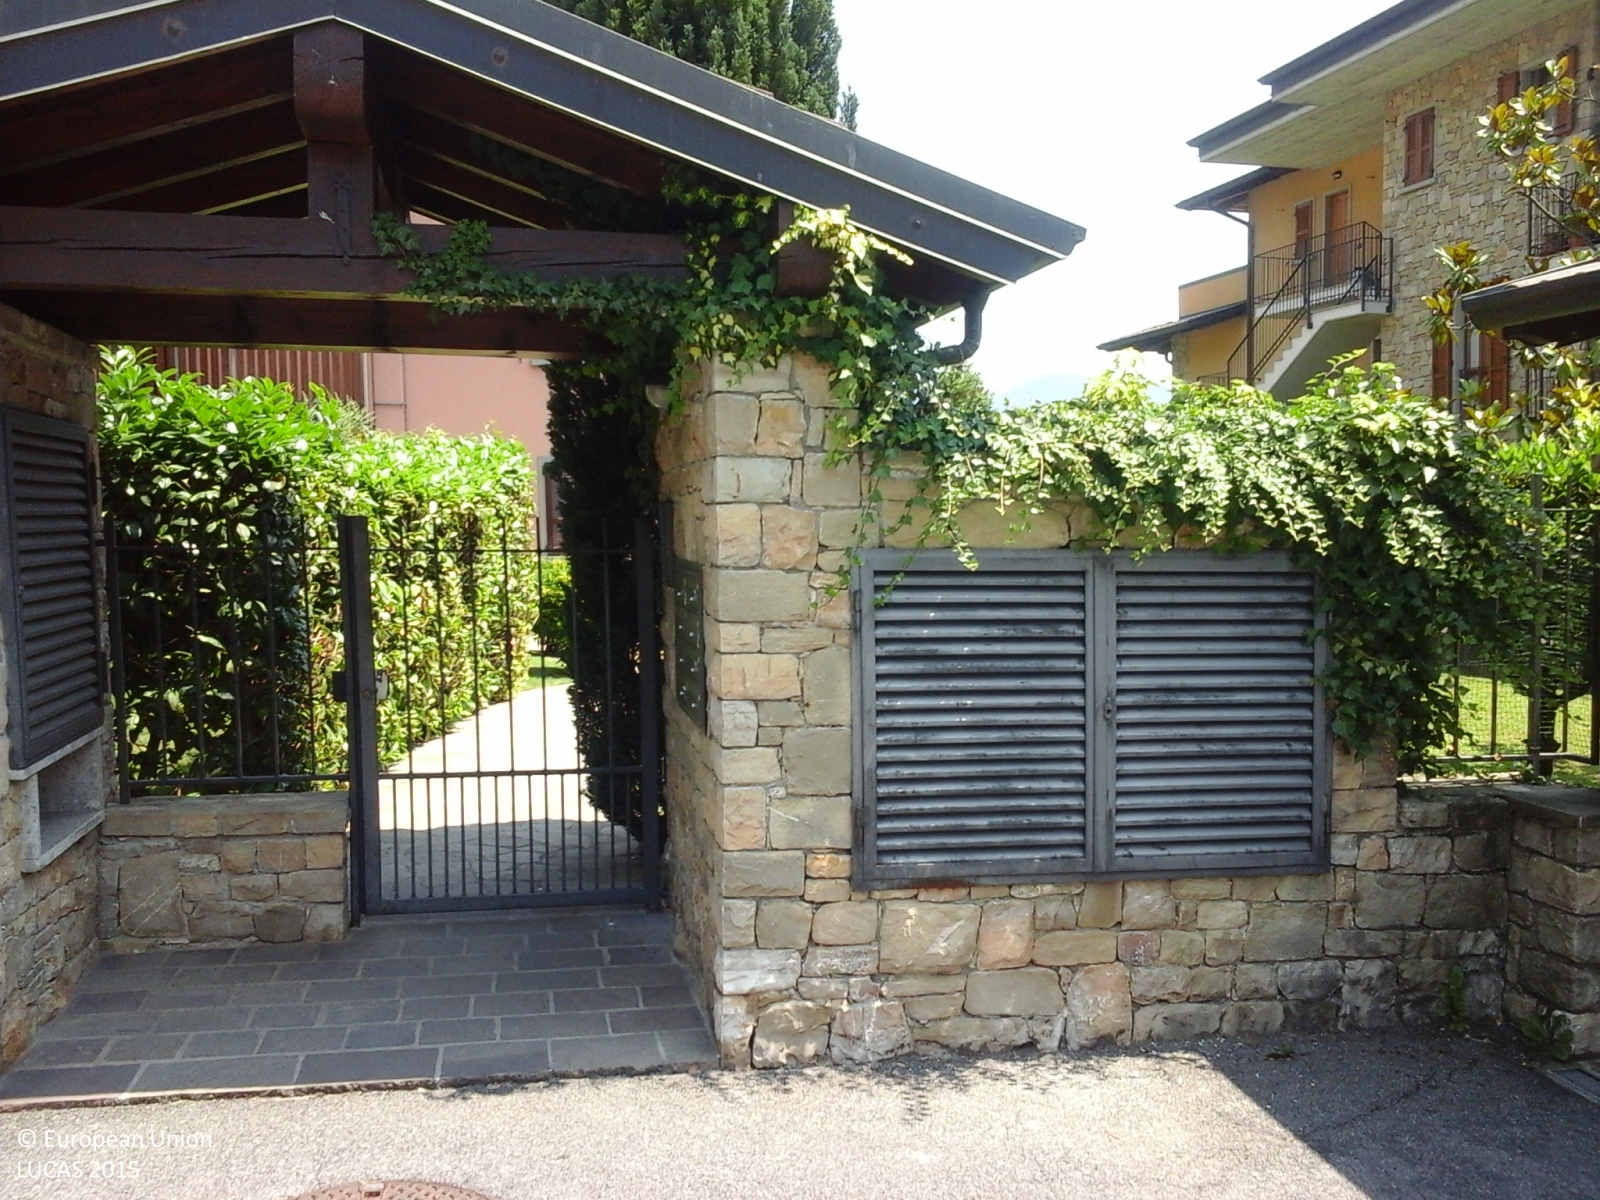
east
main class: Grassland
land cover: Grassland without tree/shrub cover
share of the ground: > 75 %
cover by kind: herbaceous plants 100 %
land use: Residential
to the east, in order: Grassland without tree/shrub cover; Artificial constructions in urban areas; Grassland without tree/shrub cover; Managed hedges; Grass margins; Paved roads, cycling and walking lanes; Grassland without tree/shrub cover; Tracks; Grassland without tree/shrub cover; Artificial constructions in urban areas
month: July
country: IT
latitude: 45.8828
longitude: 9.9357
